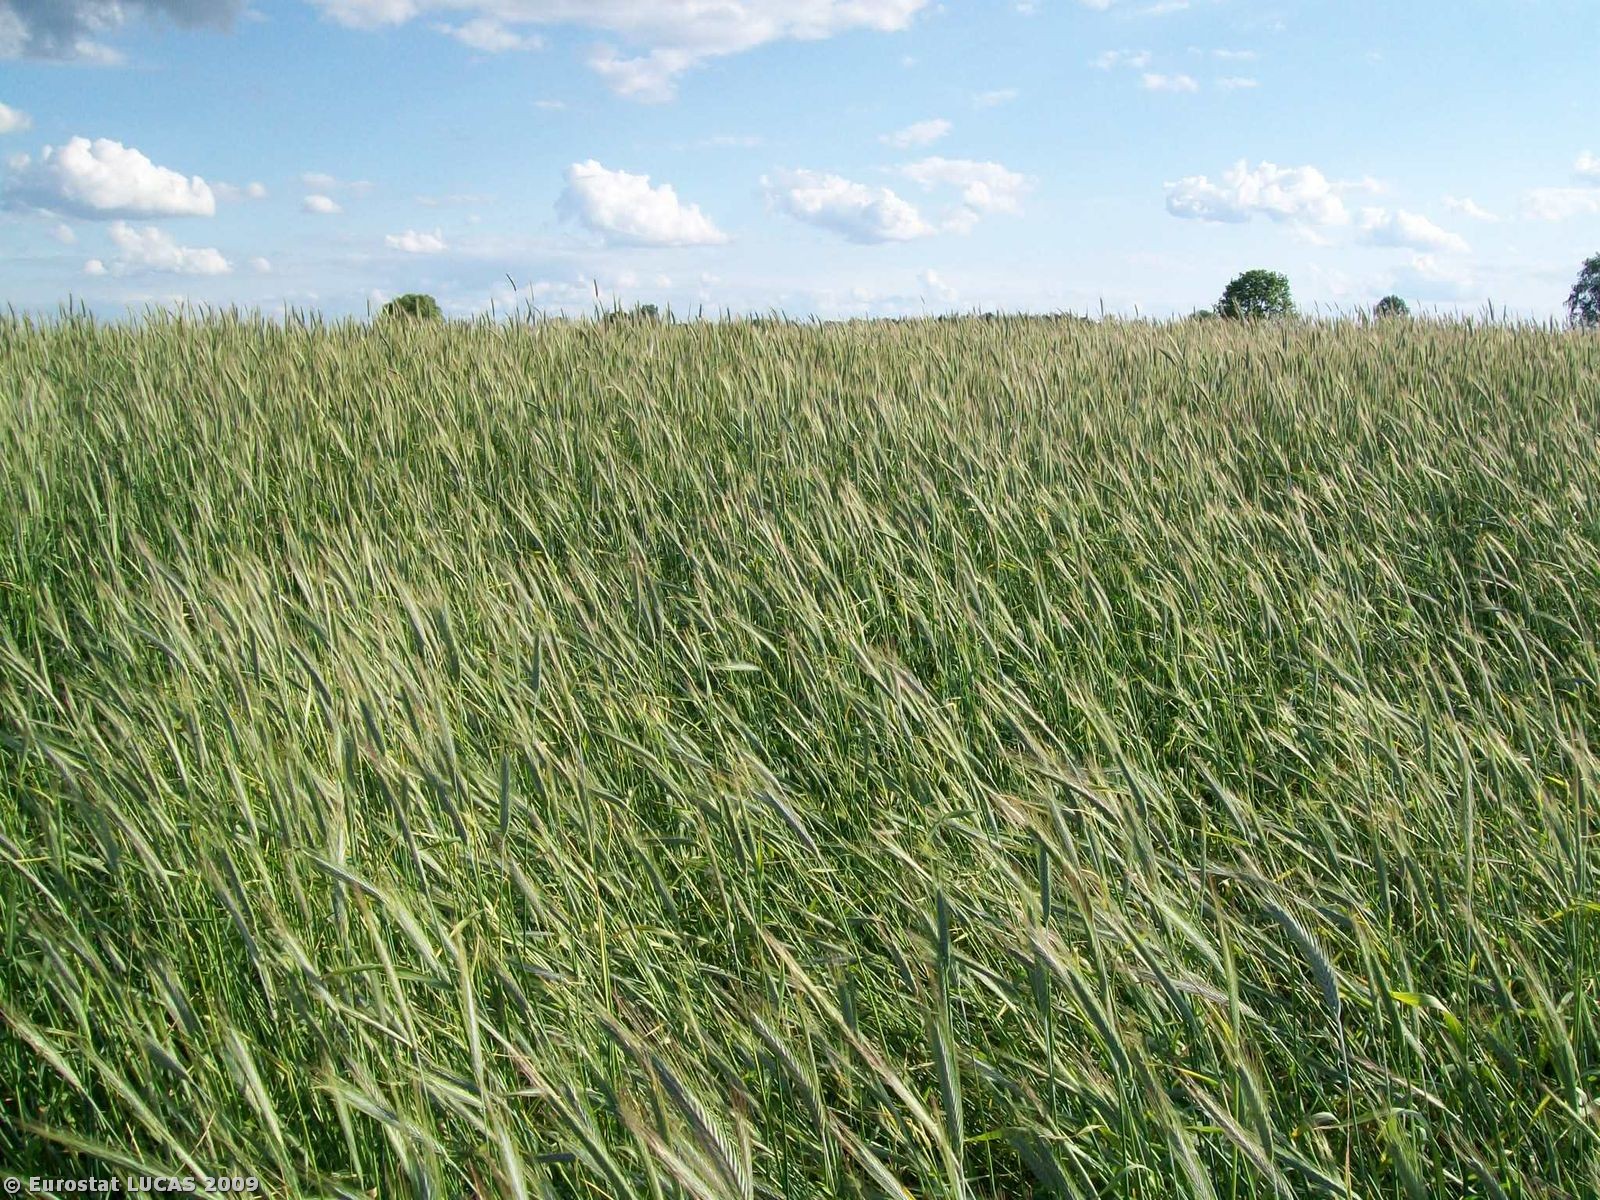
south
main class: Cropland
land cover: Rye
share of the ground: > 75 %
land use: Agriculture (excluding fallow land and kitchen gardens)
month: May
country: PL
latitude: 52.0141
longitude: 16.2574
